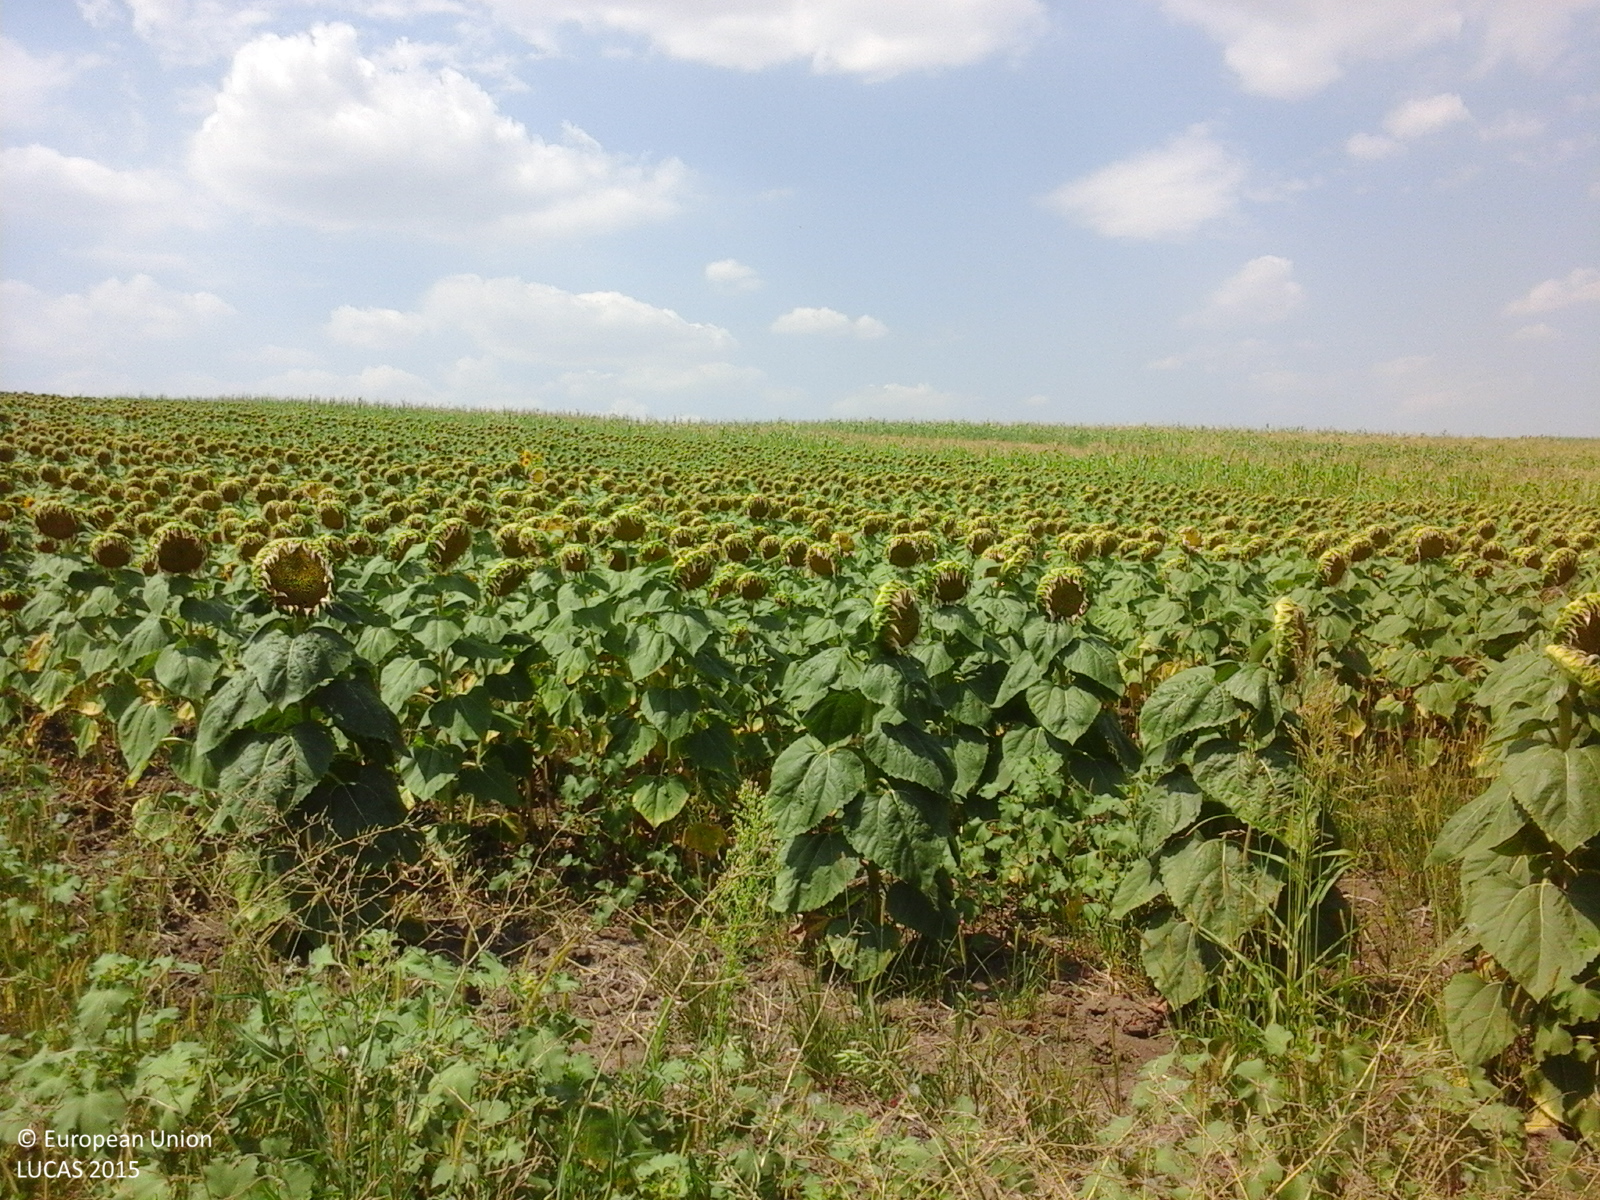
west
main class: Cropland
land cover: Sunflower
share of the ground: > 75 %
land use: Agriculture (excluding fallow land and kitchen gardens)
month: July
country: RO
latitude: 46.0745
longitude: 28.0316
